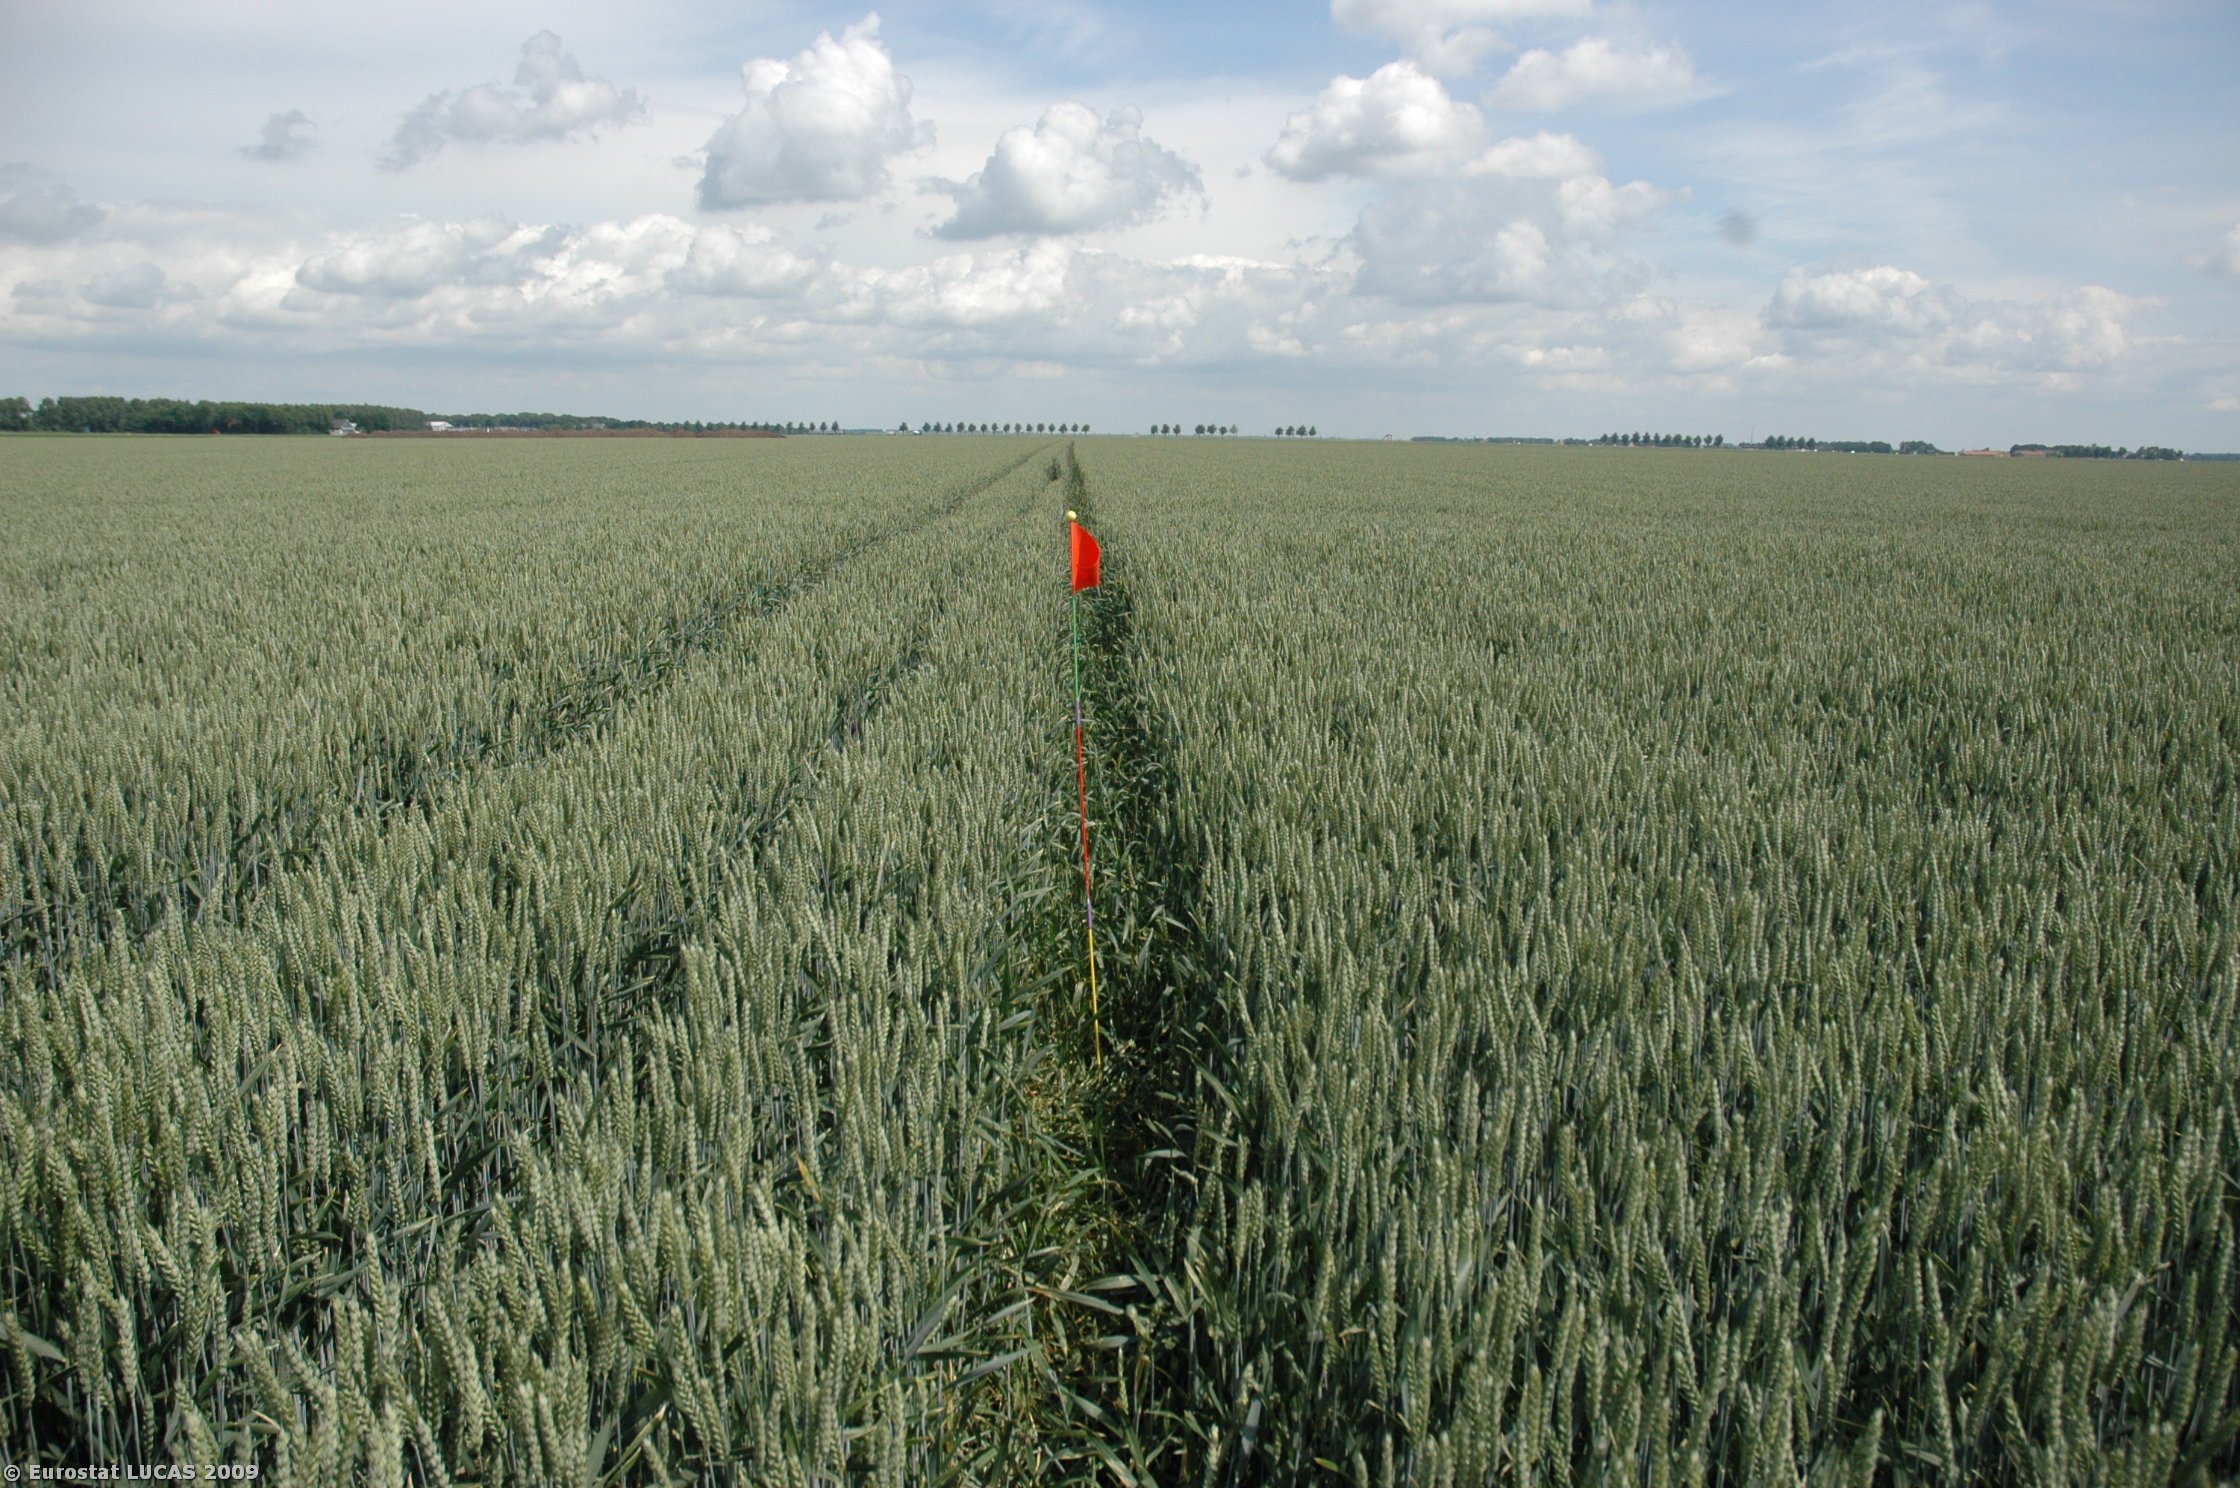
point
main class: Cropland
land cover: Common wheat
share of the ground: > 75 %
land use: Agriculture (excluding fallow land and kitchen gardens)
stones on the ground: < 10 %
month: June
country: NL
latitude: 52.5498
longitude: 5.6482
